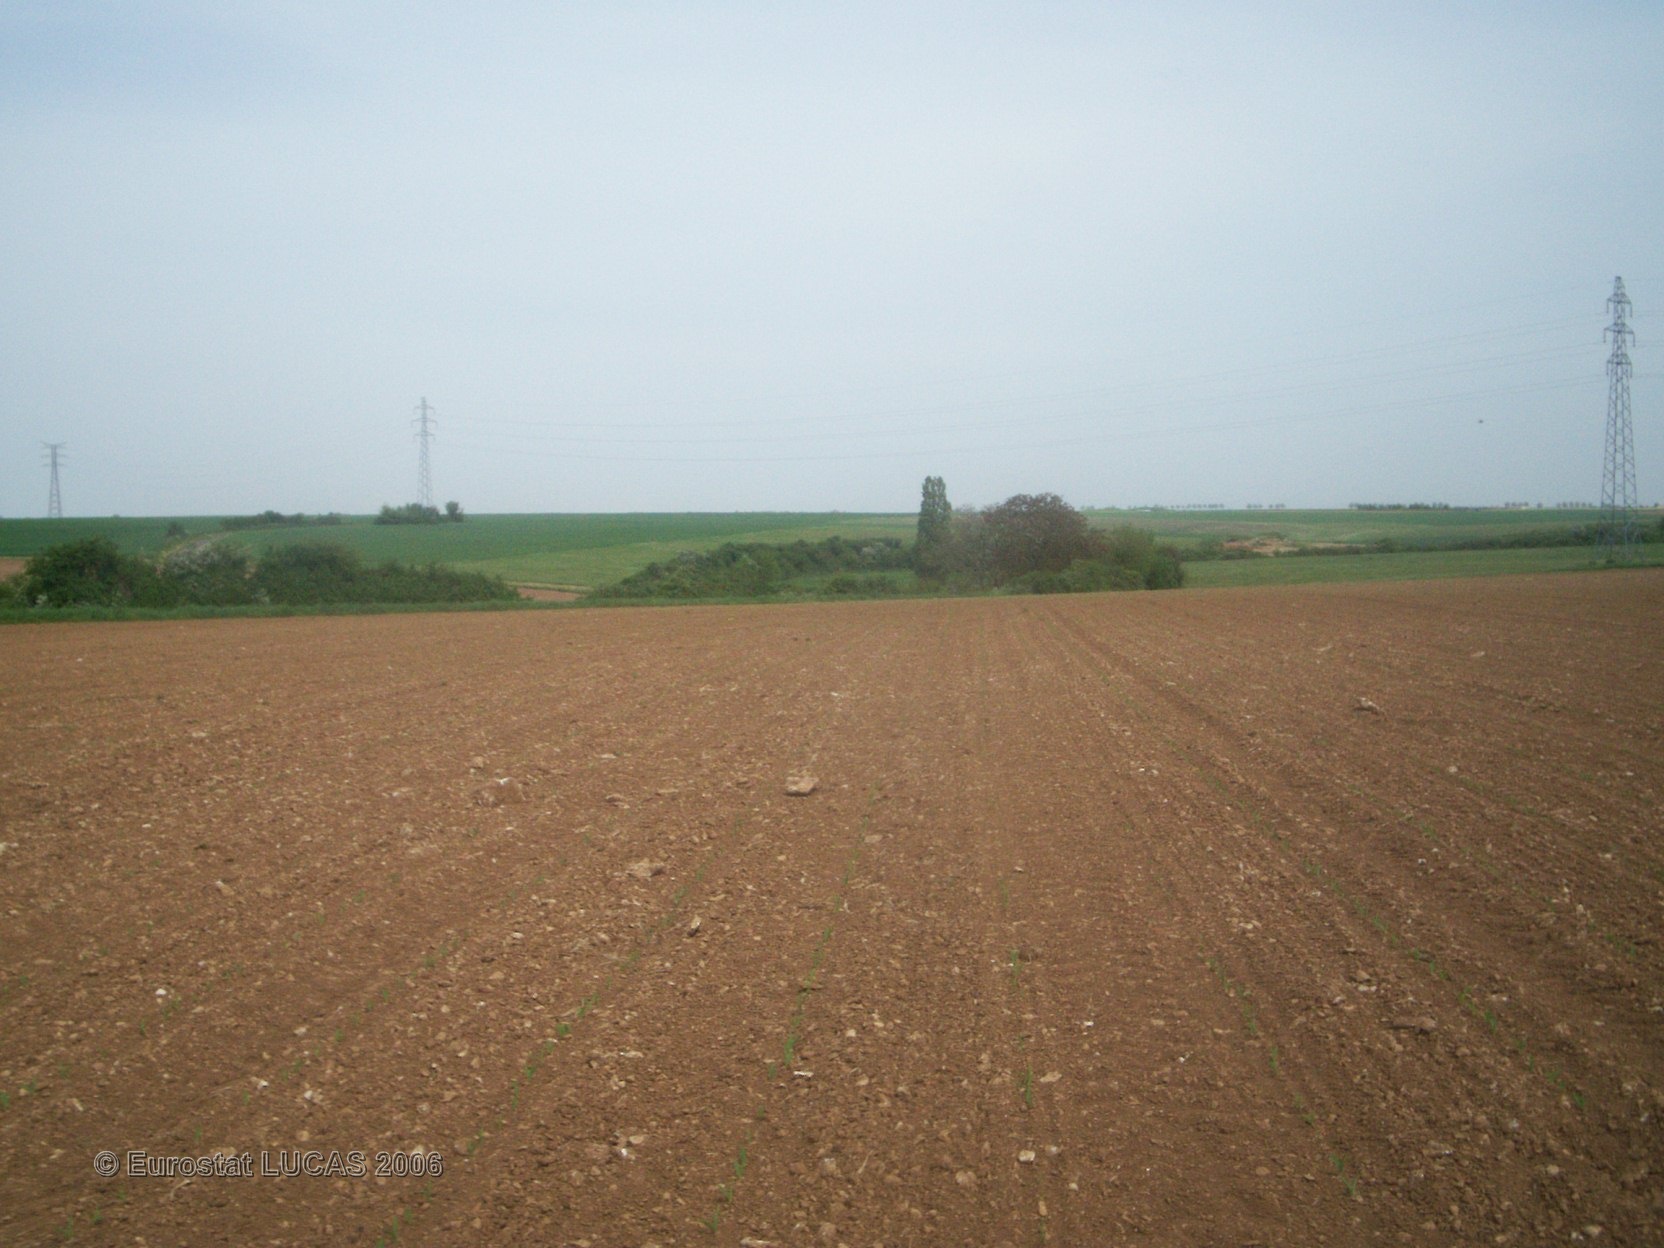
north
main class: Cropland
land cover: Maize
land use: Agriculture (excluding fallow land and kitchen gardens)
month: May
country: FR
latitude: 46.4741
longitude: -0.9848
